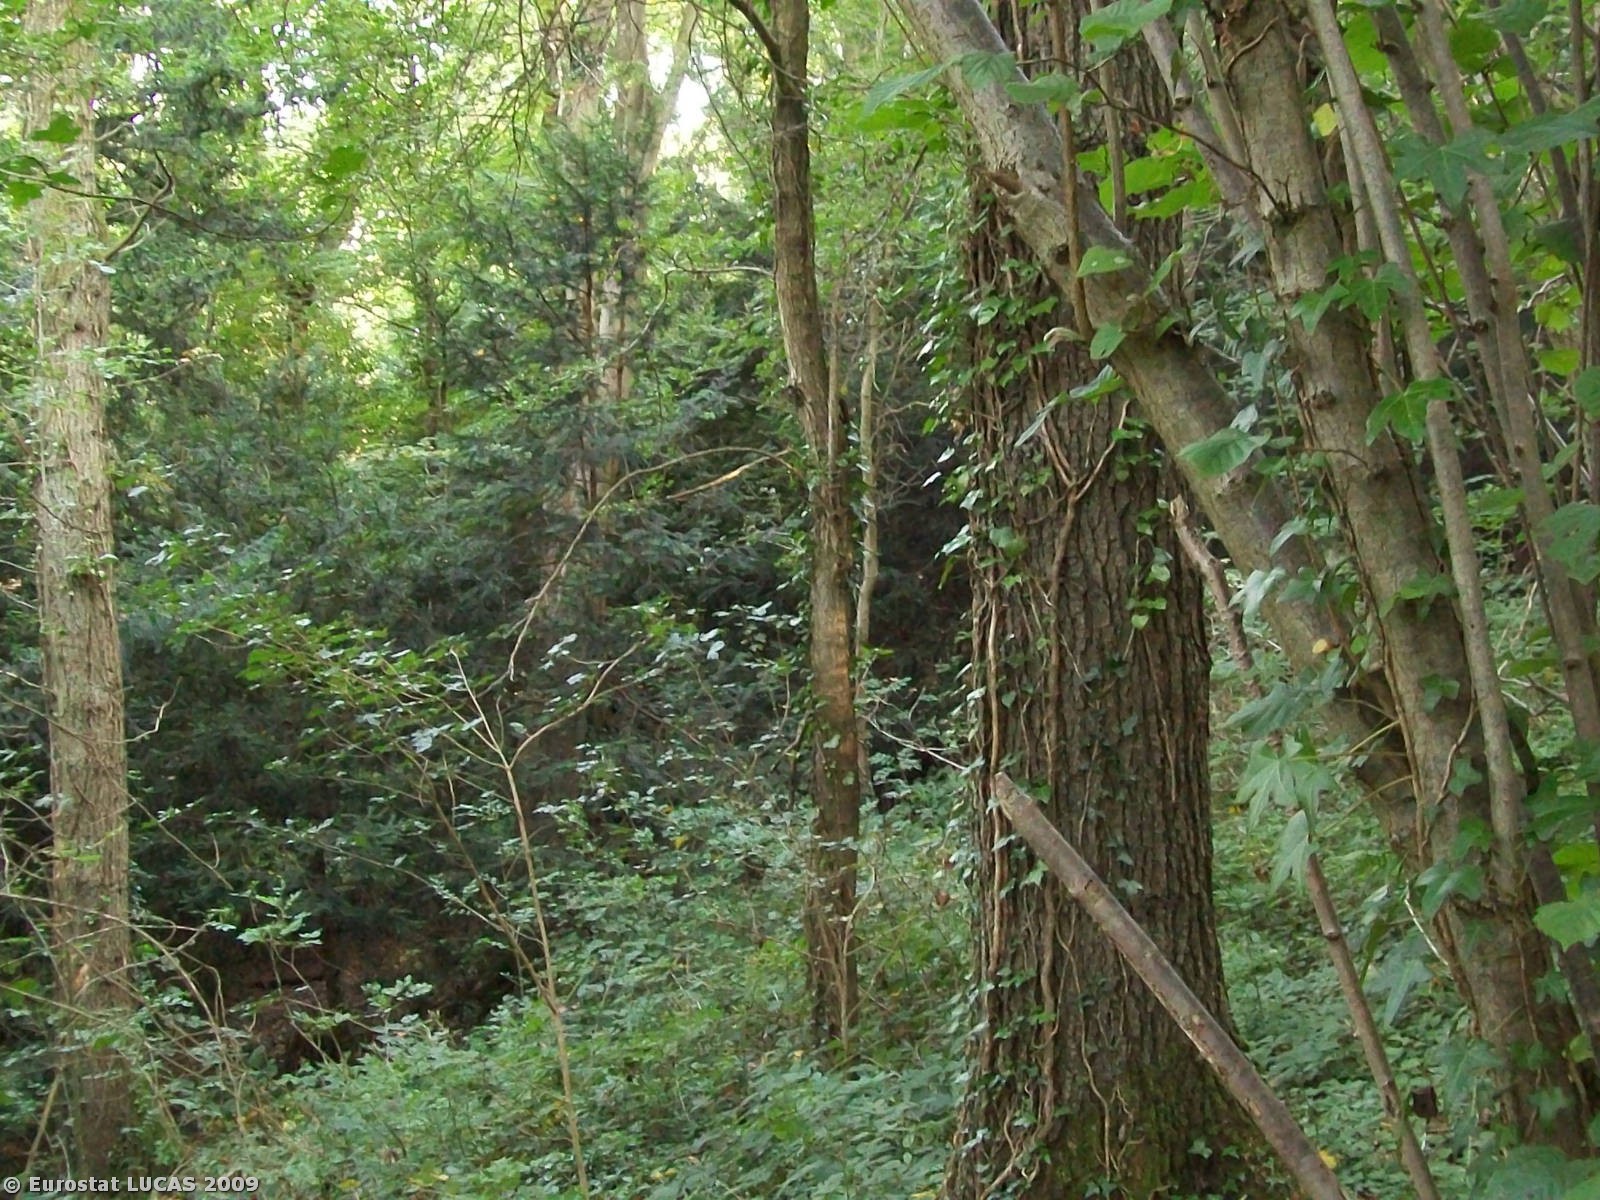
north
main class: Woodland
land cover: Broadleaved woodland
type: mesophytic deciduous forest
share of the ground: > 75 %
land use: Community services
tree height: > 5 m
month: September
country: GB
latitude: 52.1445
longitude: -2.3833
